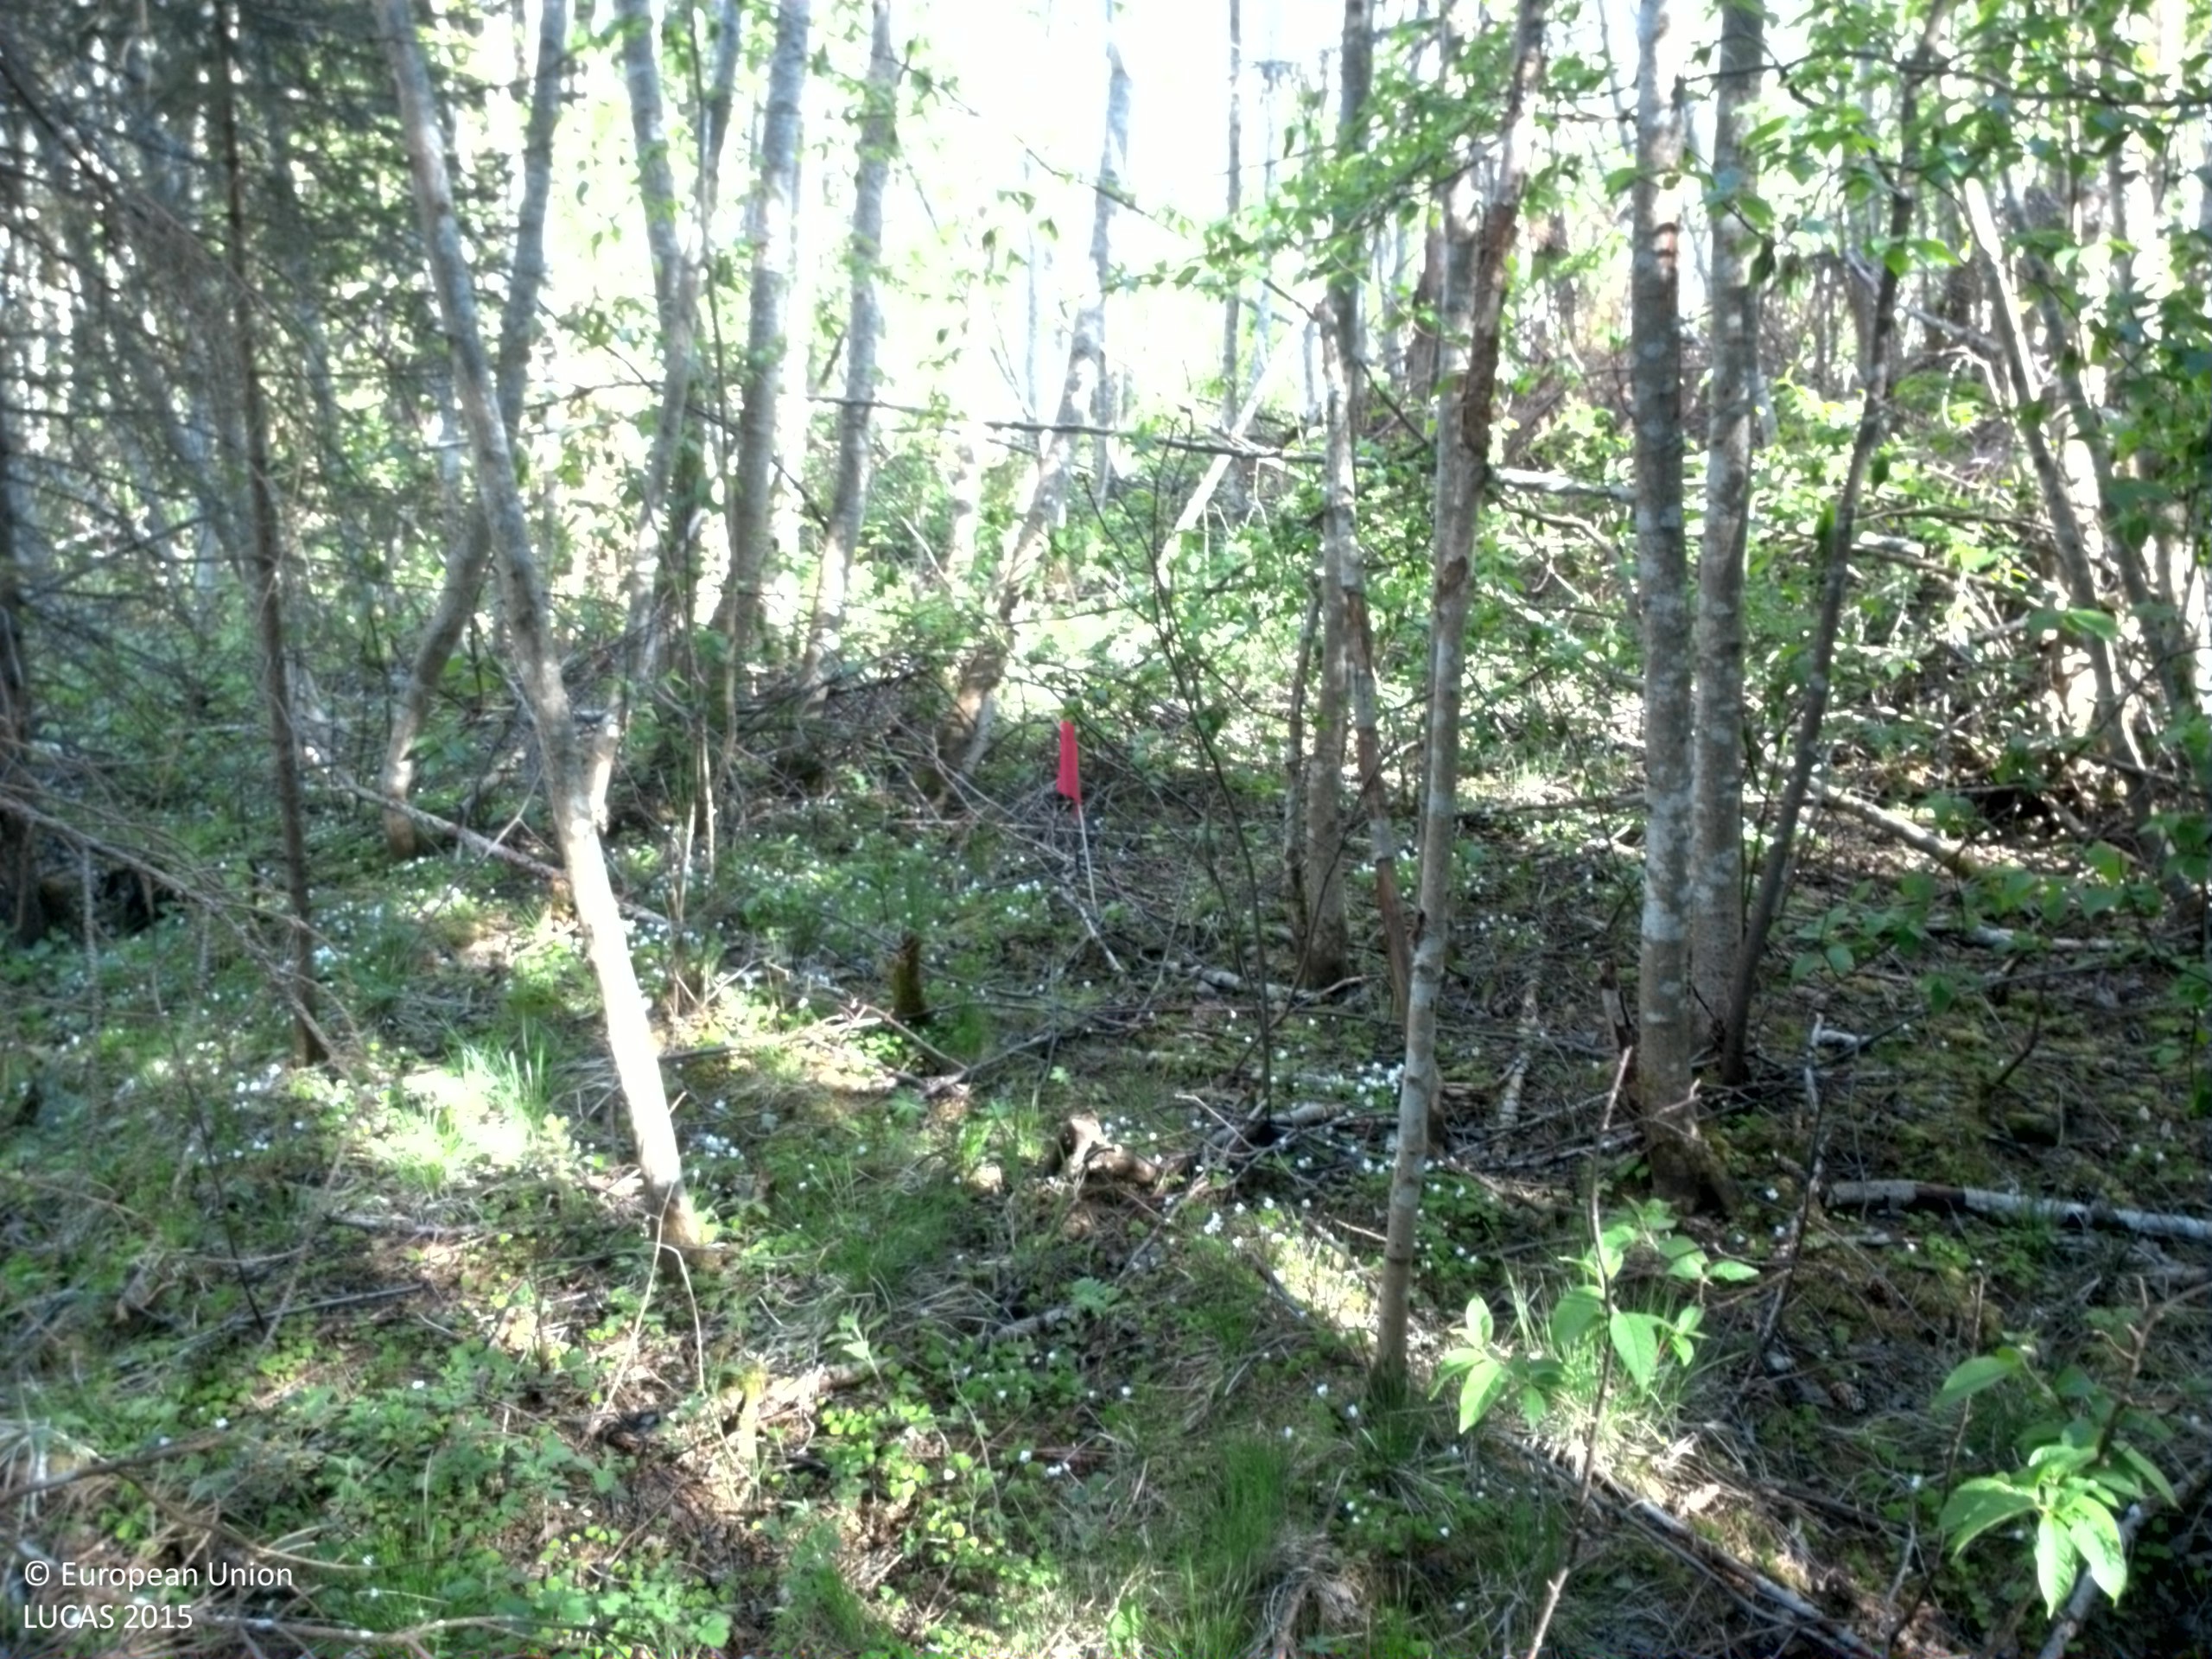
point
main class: Woodland
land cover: Broadleaved woodland
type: hemiboreal forest and nemoral coniferous forest and mixed broadleaved-coniferous forest
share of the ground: > 75 %
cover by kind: broadleaved forest trees 80 %, coniferous forest trees 10 %, herbaceous plants 10 %
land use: Forestry
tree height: > 5 m
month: May
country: SE
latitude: 63.0791
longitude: 17.8367
